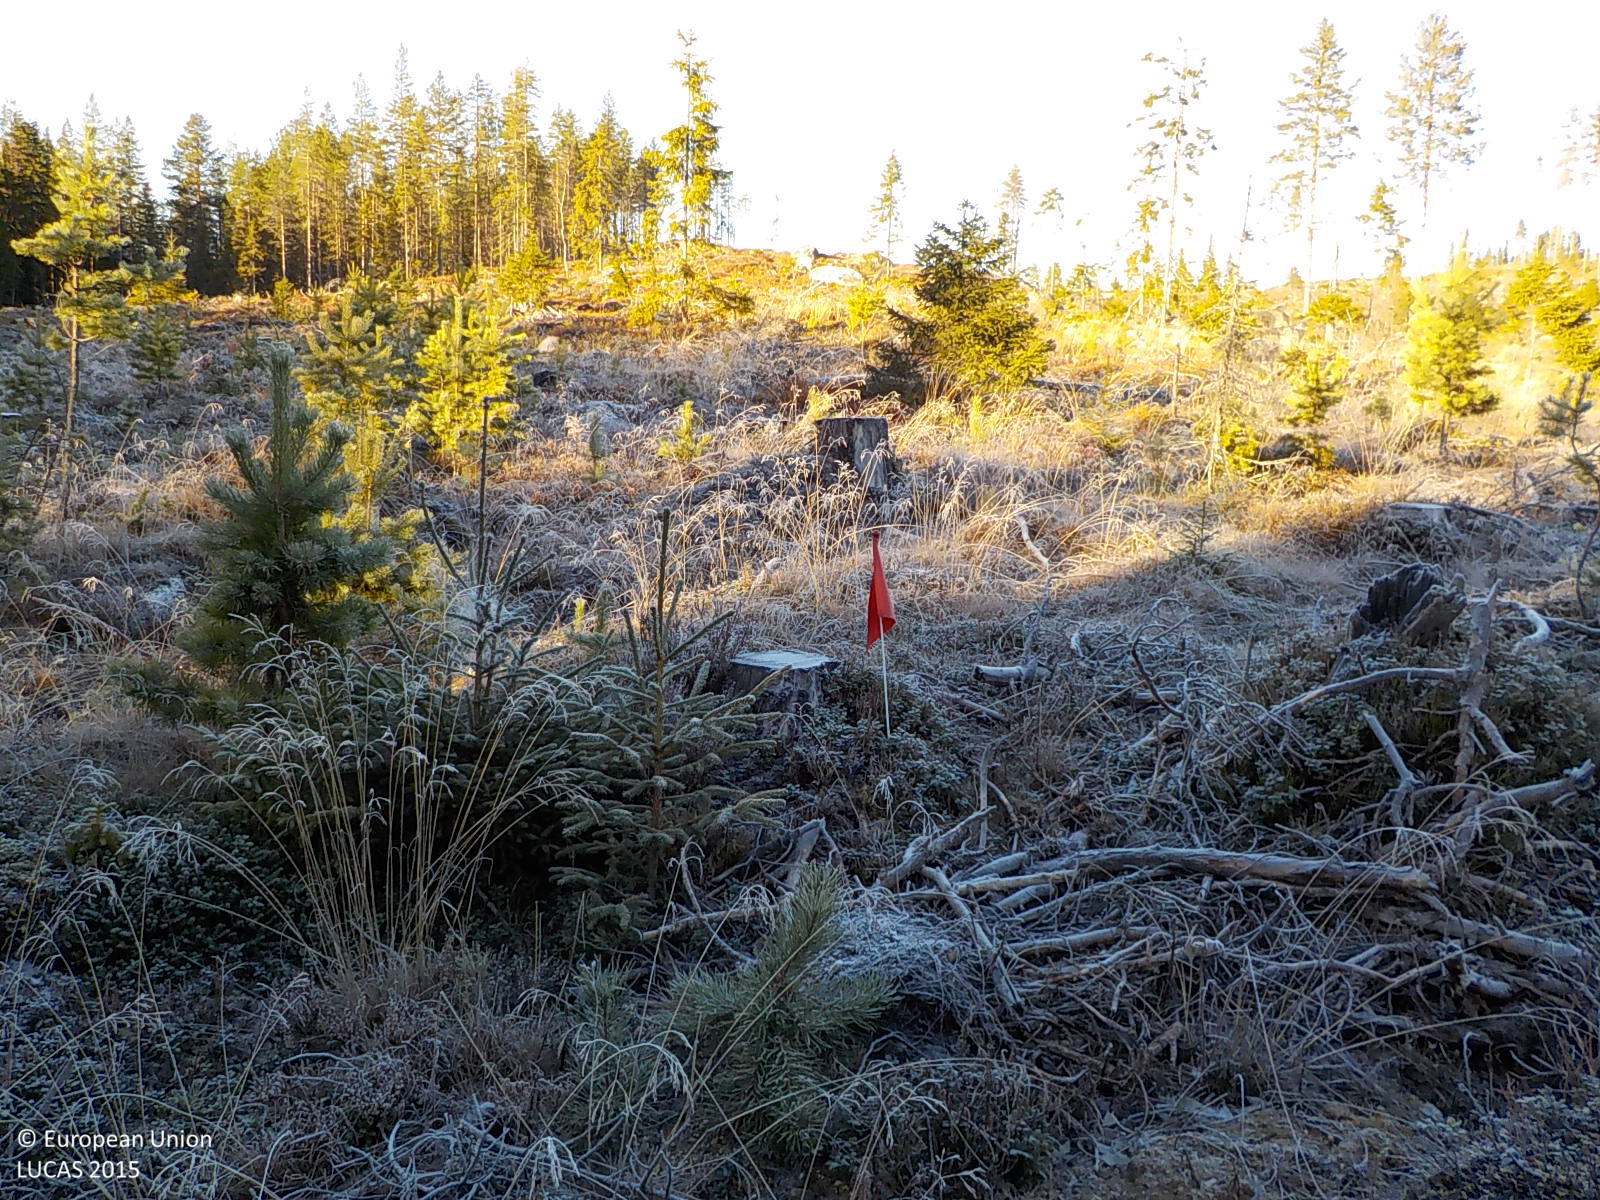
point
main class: Woodland
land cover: Pine dominated coniferous woodland
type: boreal forest
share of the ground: 50 - 75 %
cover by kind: coniferous forest trees 50 %, shrubs 30 %, herbaceous plants 10 %, lichens and mosses 5 %
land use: Forestry
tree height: < 5 m
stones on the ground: 10 - 25 %
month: October
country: SE
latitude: 63.6013
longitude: 16.7667
